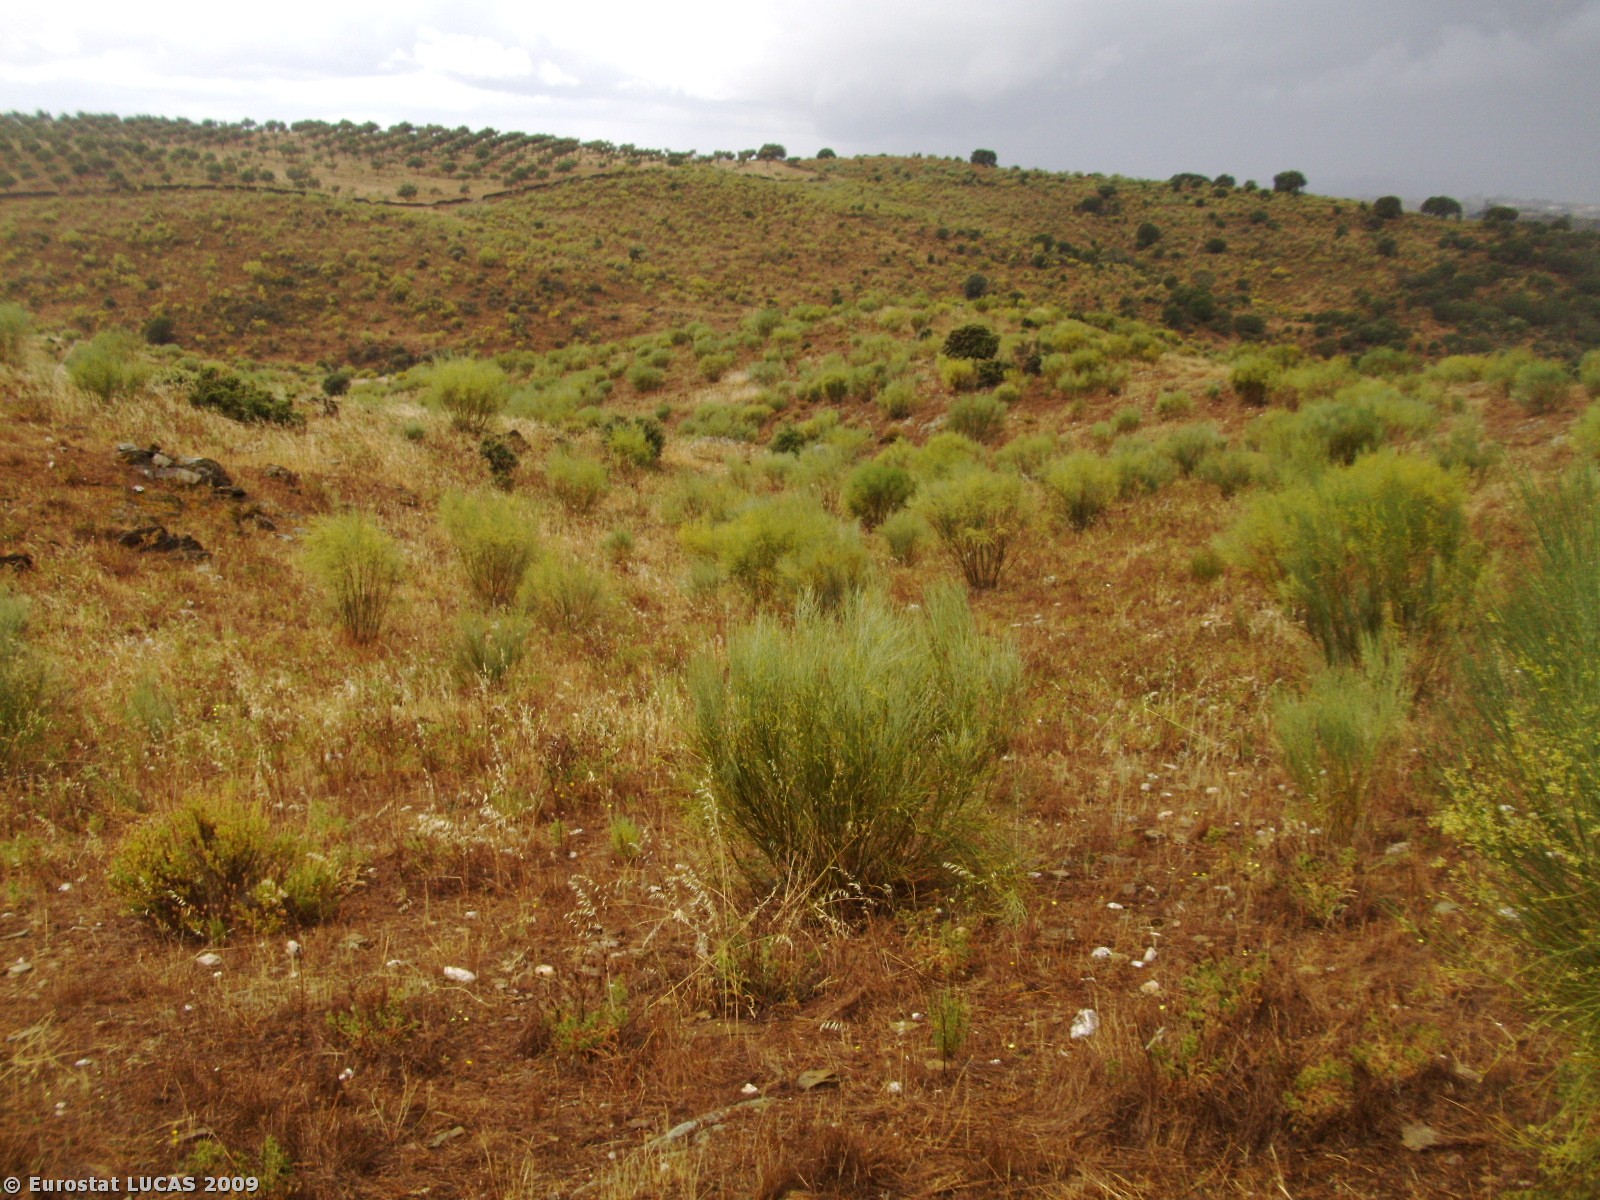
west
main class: Shrubland
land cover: Shrubland without tree cover
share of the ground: > 75 %
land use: Unused
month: June
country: PT
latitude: 39.7385
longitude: -7.1612
